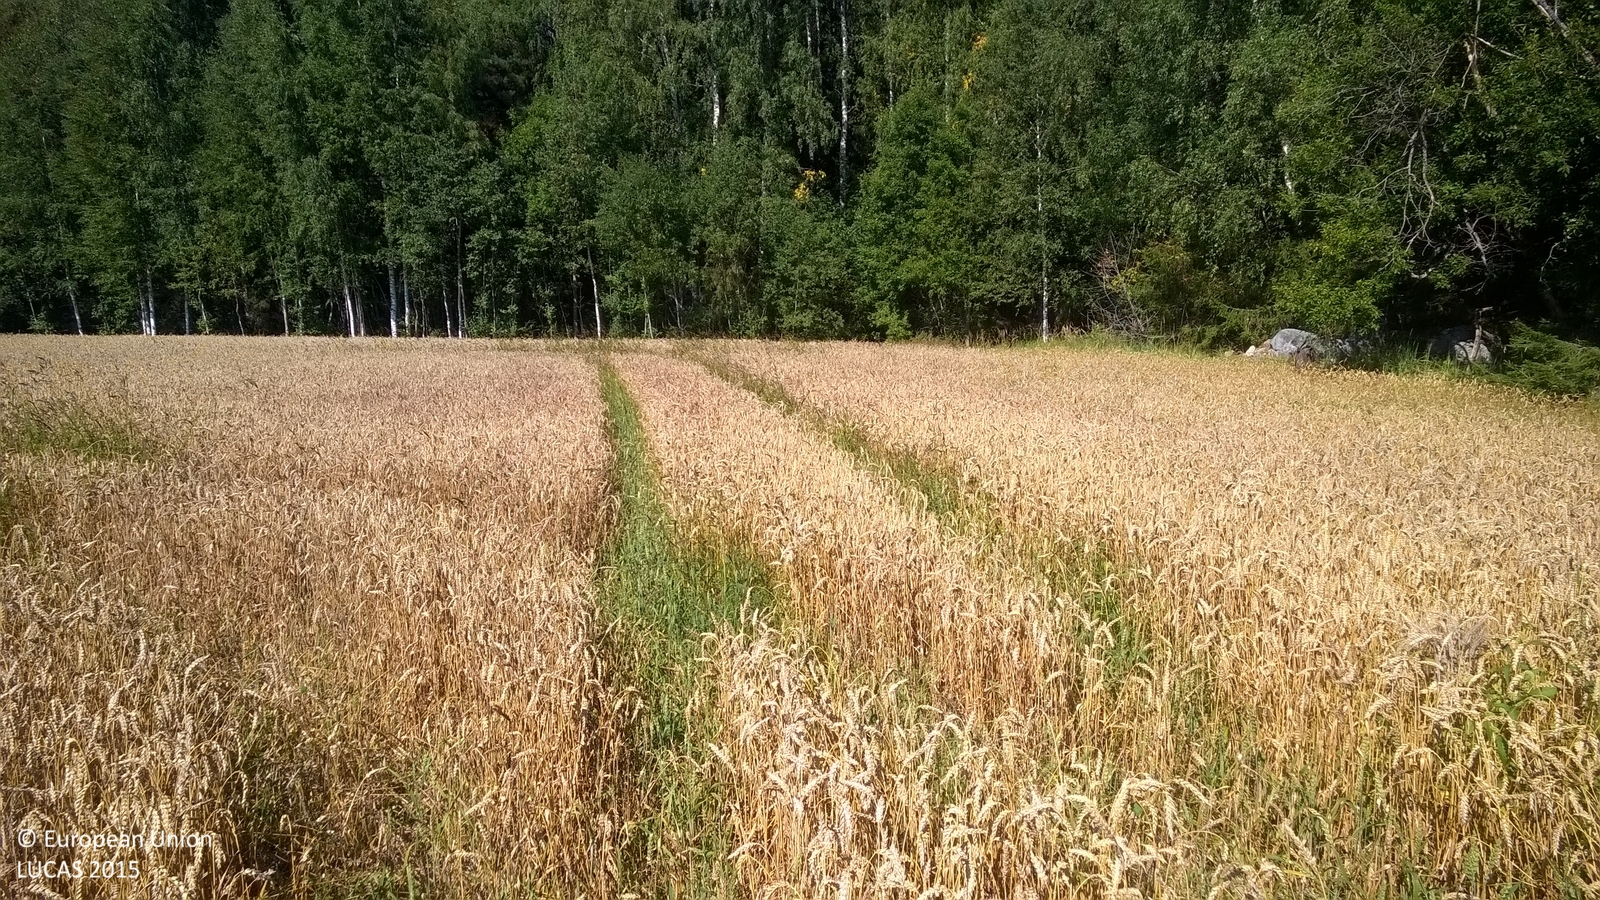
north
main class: Cropland
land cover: Common wheat
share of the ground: > 75 %
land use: Agriculture (excluding fallow land and kitchen gardens)
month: August
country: LV
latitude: 57.5476
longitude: 25.9844
